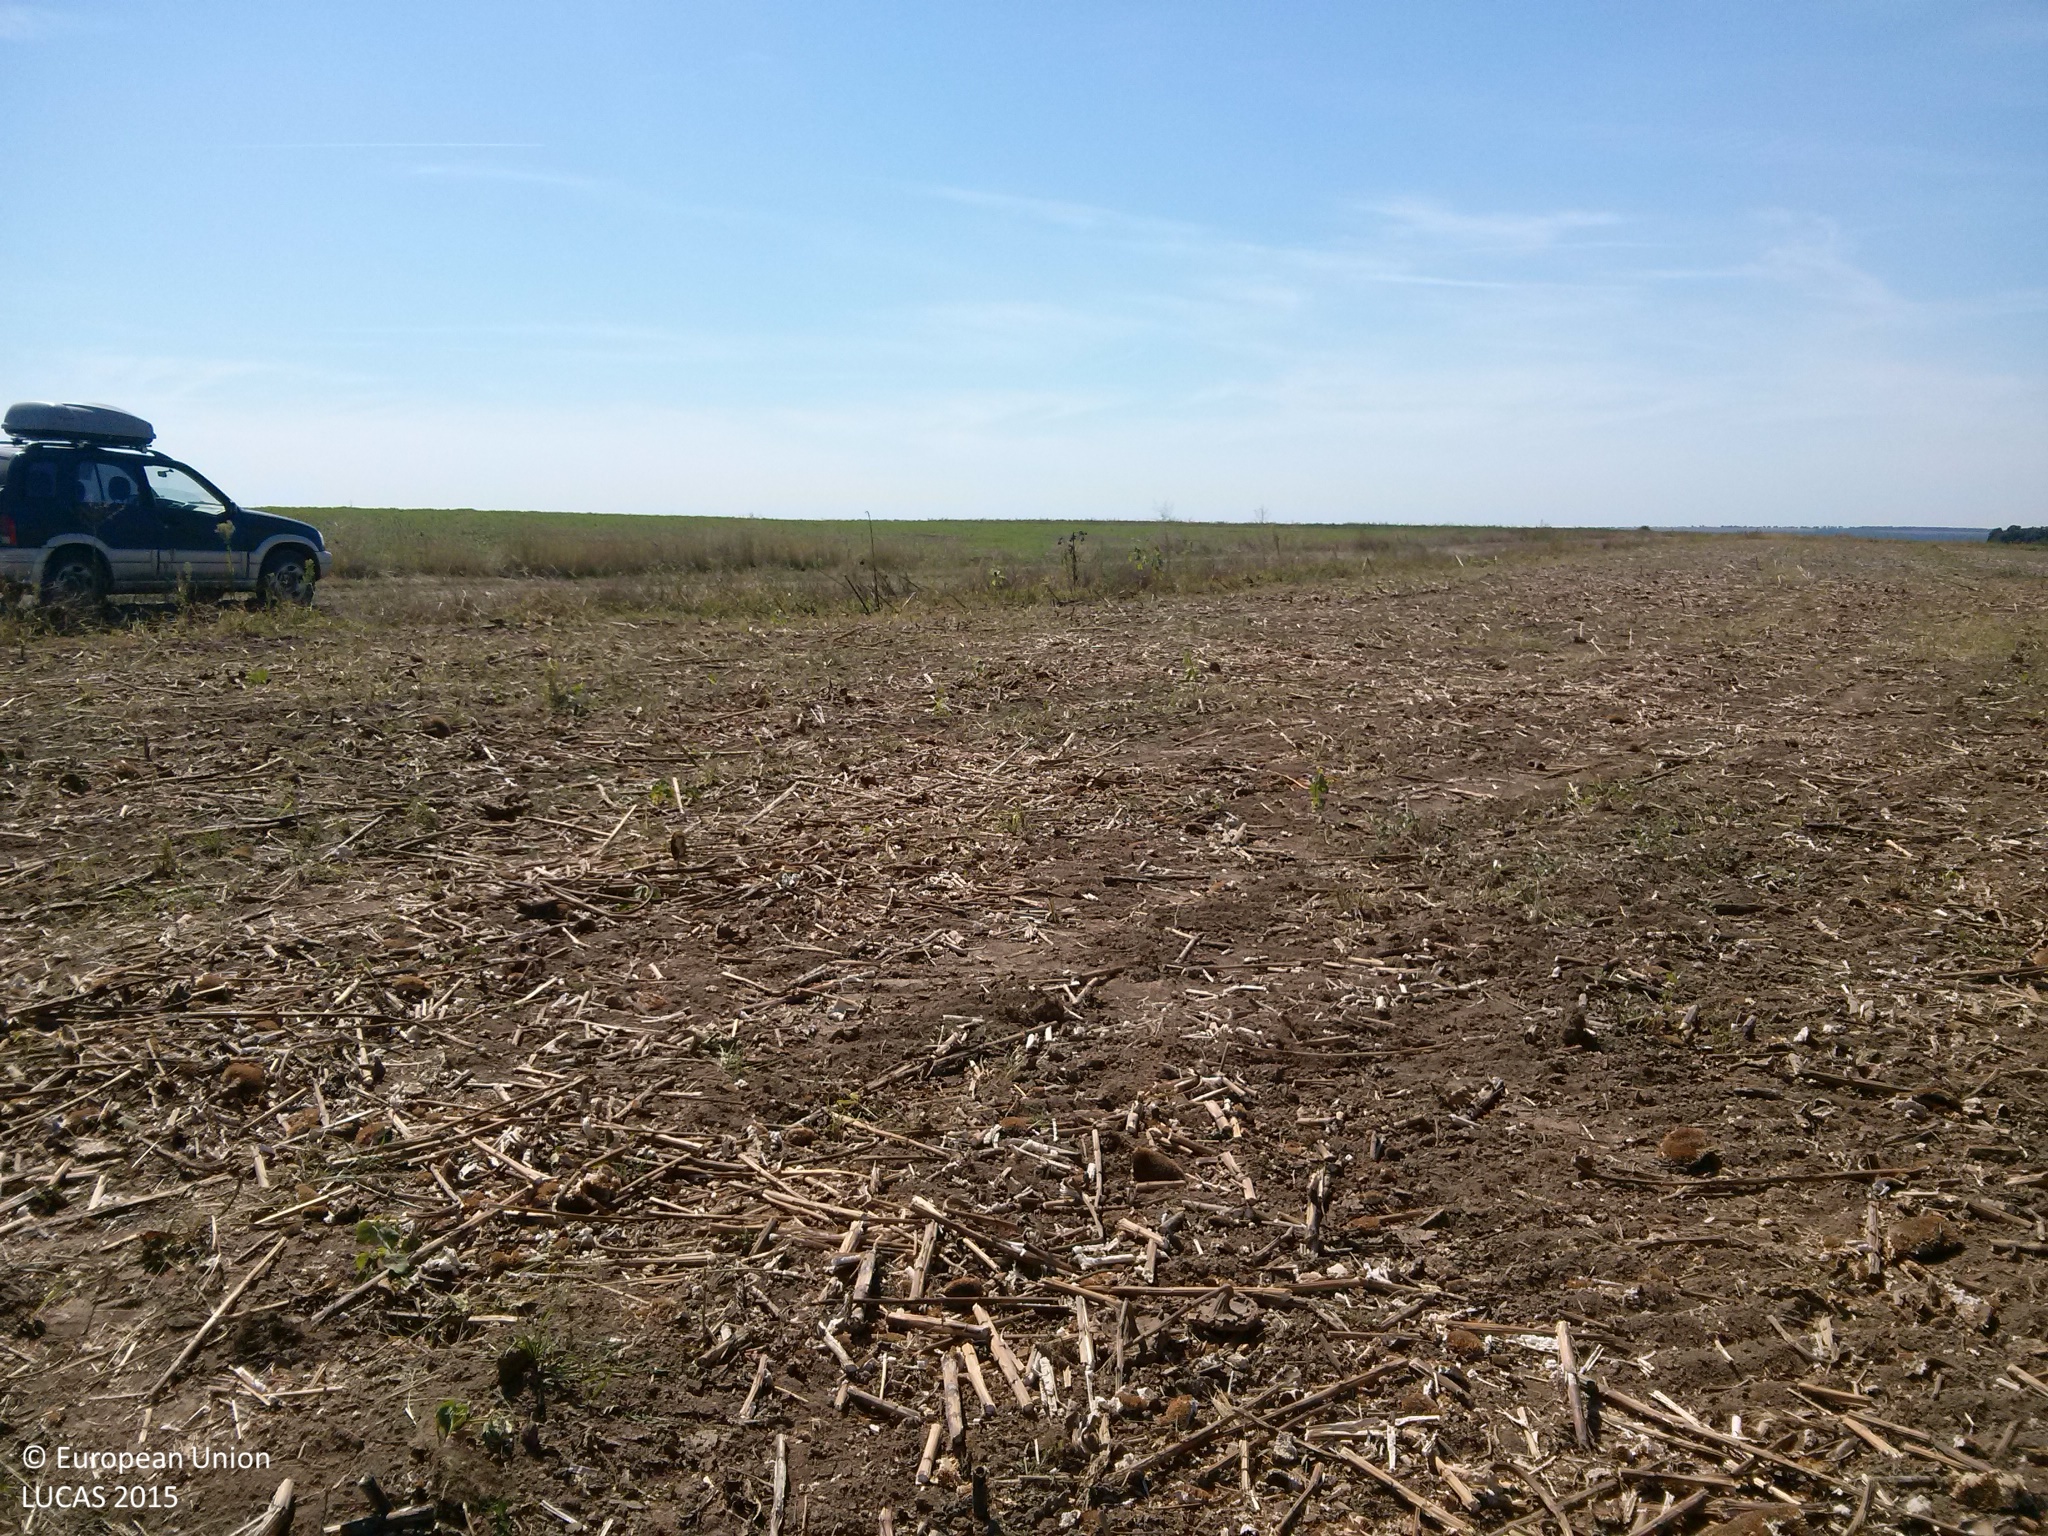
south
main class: Cropland
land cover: Sunflower
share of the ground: < 10 %
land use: Agriculture (excluding fallow land and kitchen gardens)
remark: Harvested field
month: September
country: BG
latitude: 43.6699
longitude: 26.3372
